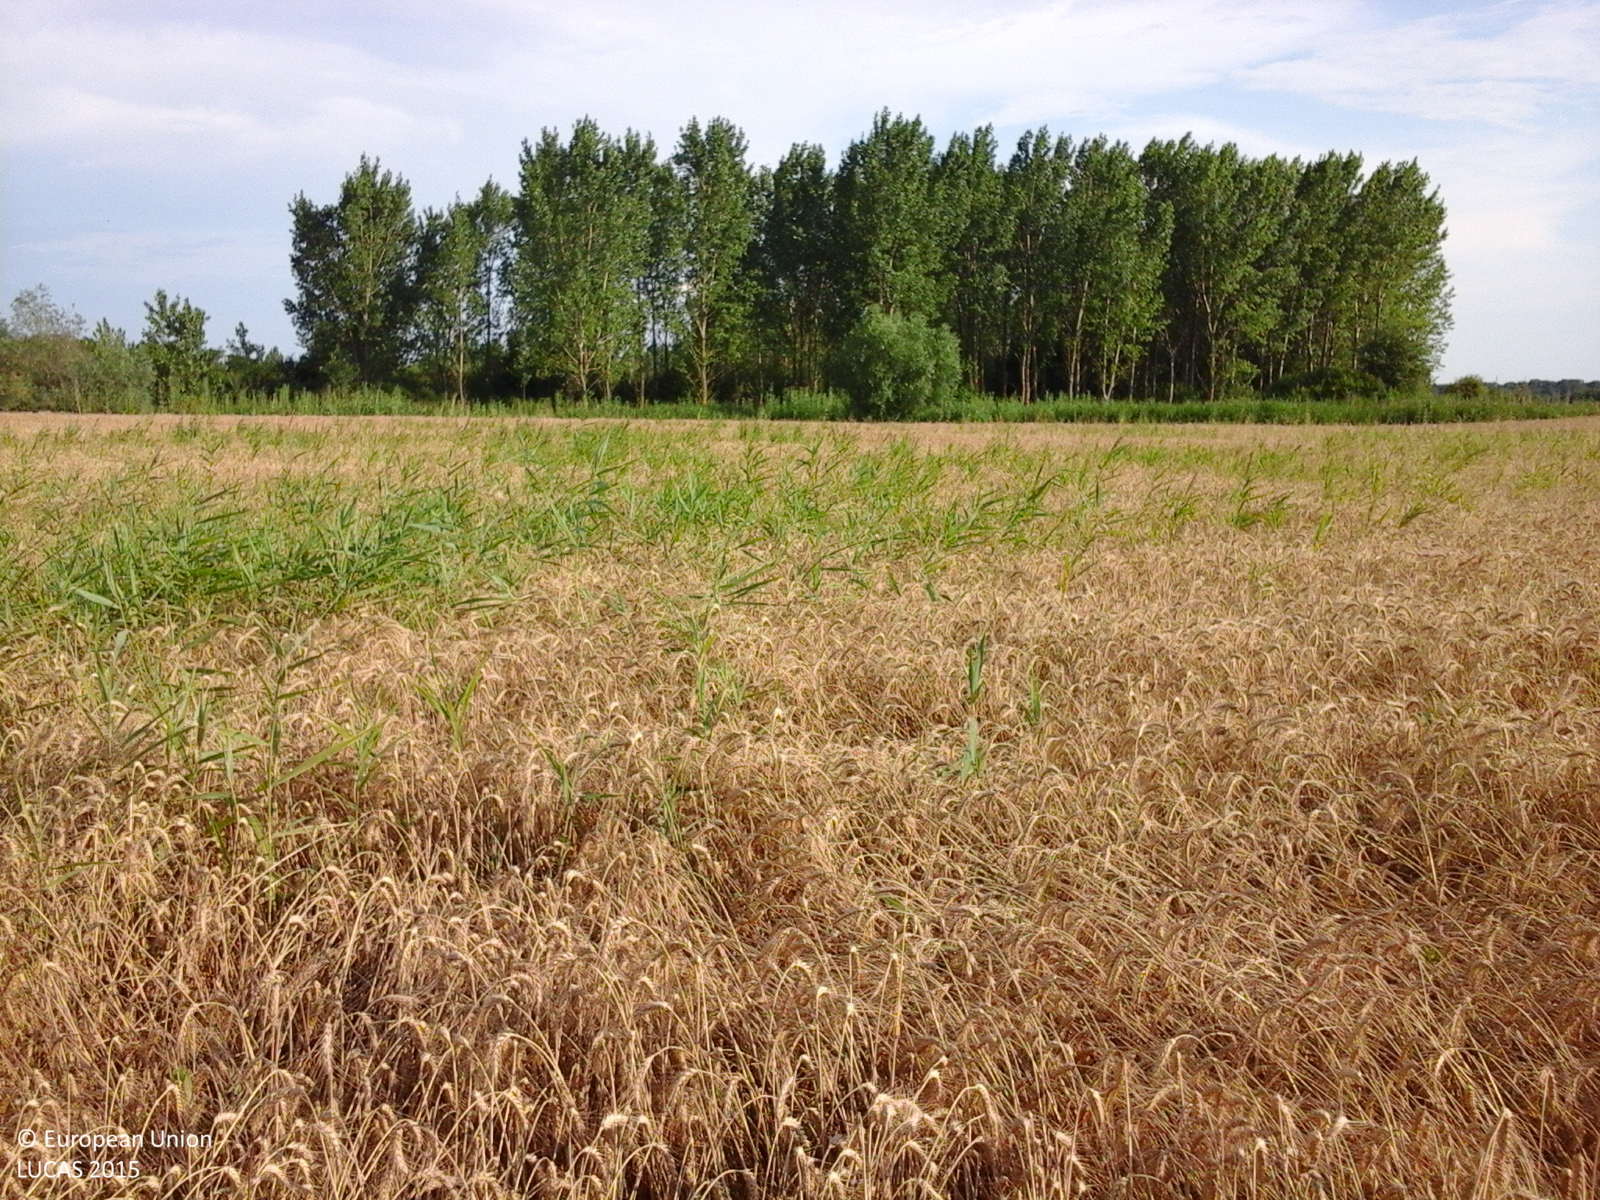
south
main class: Cropland
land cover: Common wheat
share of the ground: > 75 %
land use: Agriculture (excluding fallow land and kitchen gardens)
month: July
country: RO
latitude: 44.1728
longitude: 24.4632
